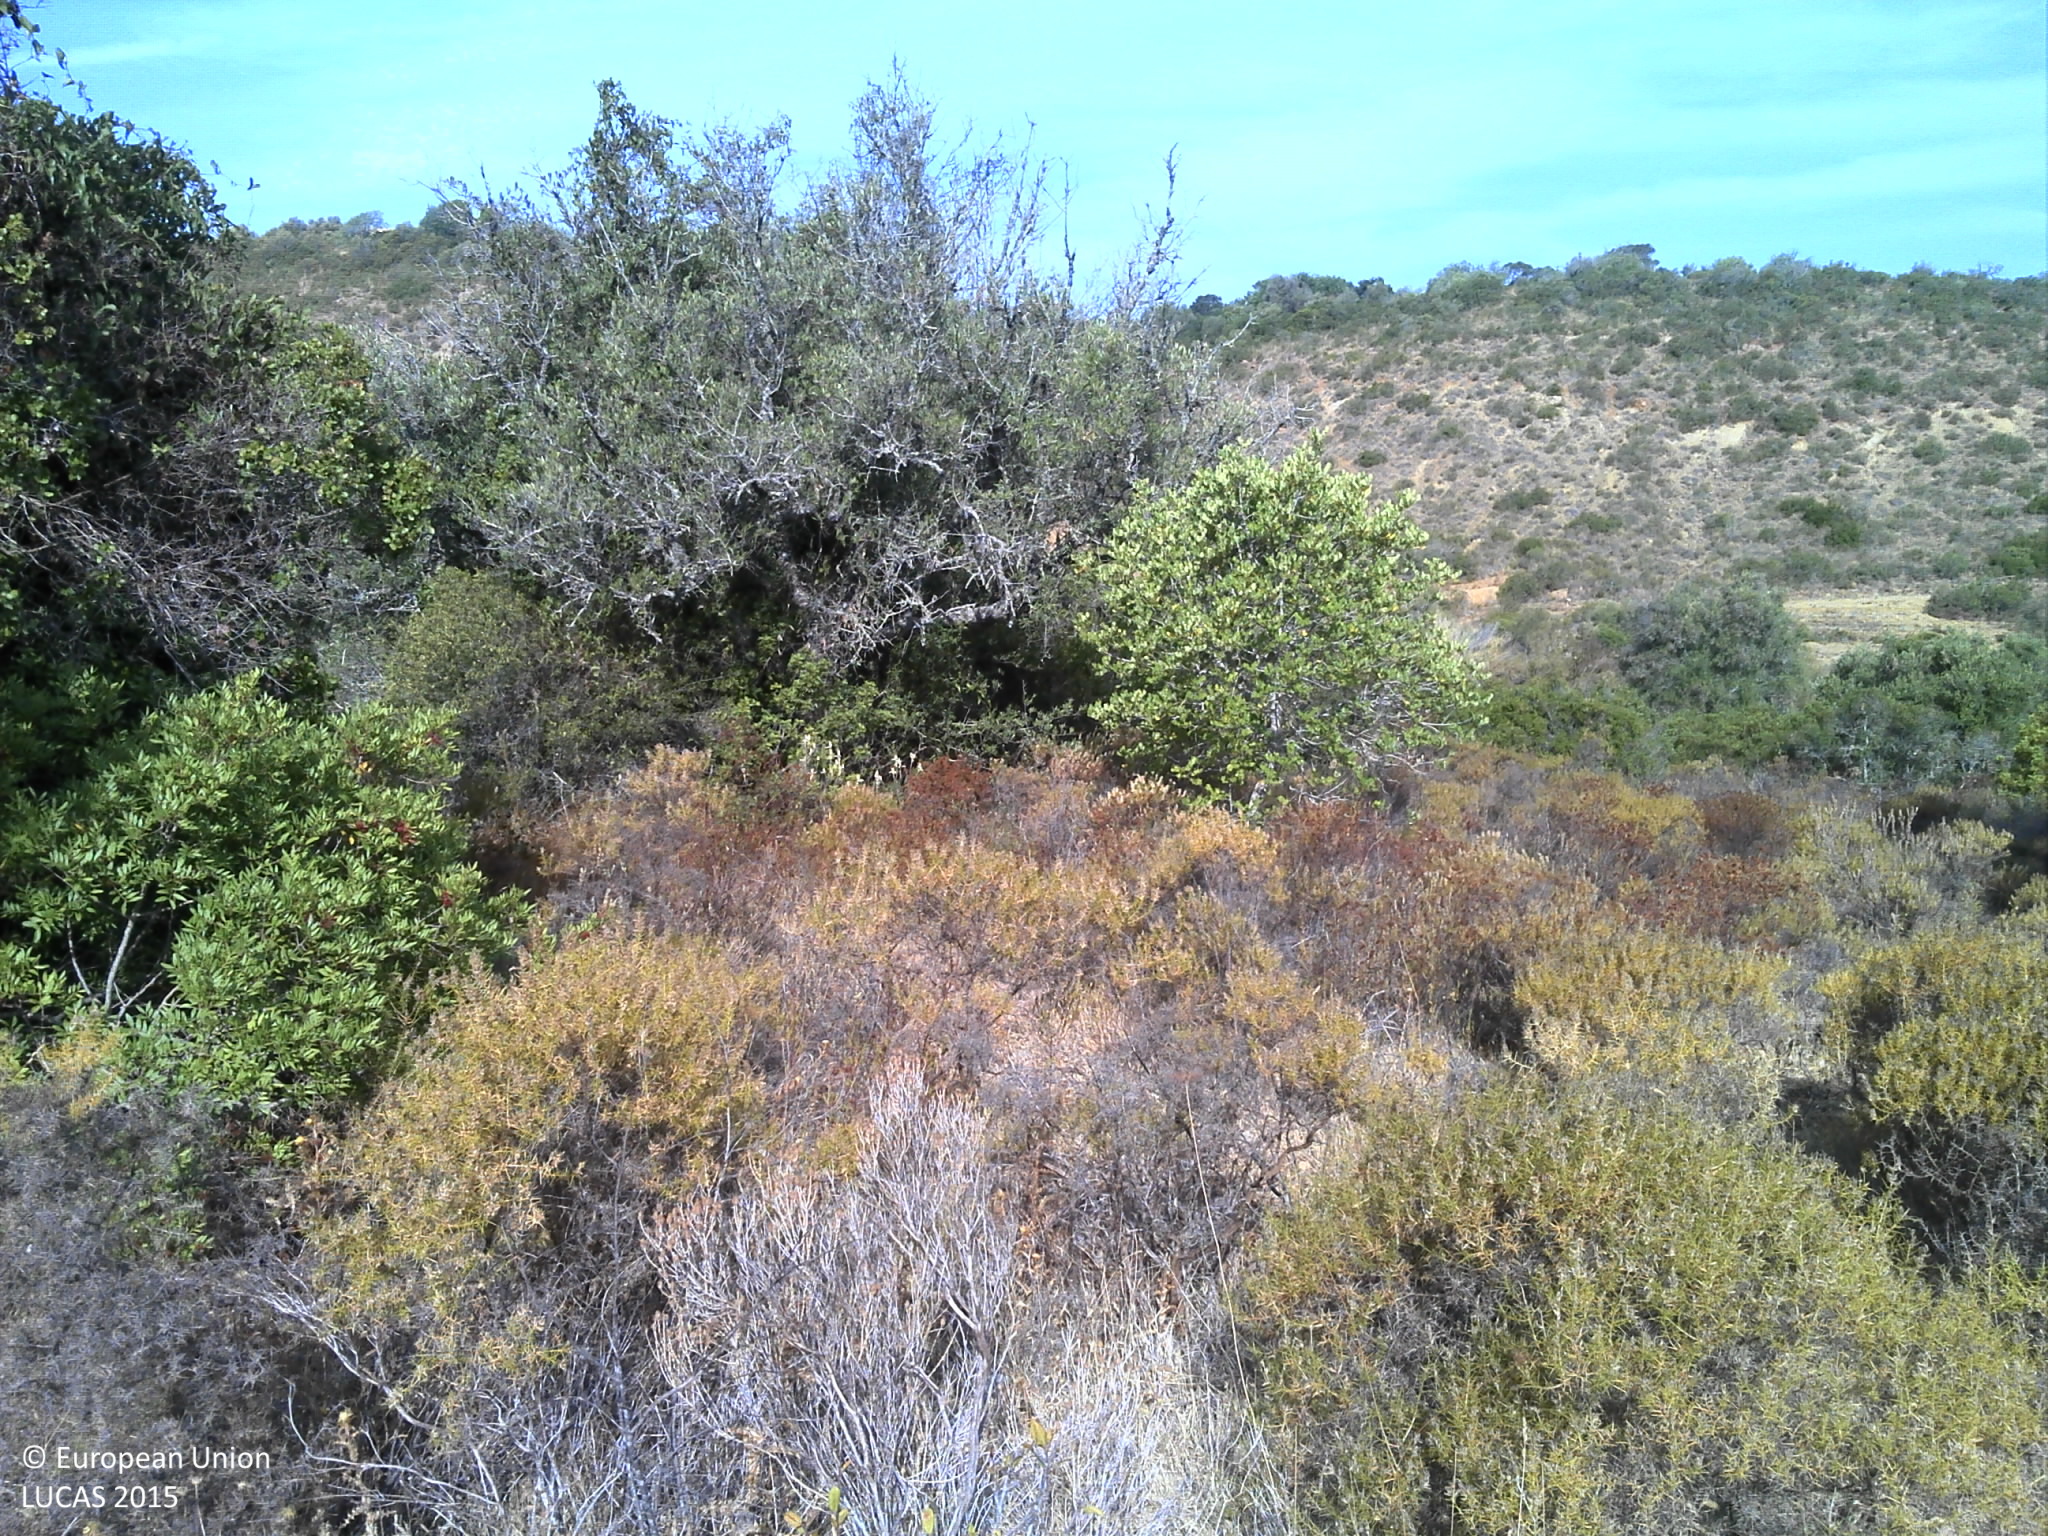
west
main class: Shrubland
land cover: Shrubland with sparse tree cover
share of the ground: 25 - 50 %
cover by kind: shrubs 40 %, unconsolidated bare surface 35 %, herbaceous plants 20 %, broadleaved forest trees 5 %
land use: Agriculture (excluding fallow land and kitchen gardens)
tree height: < 5 m
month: September
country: PT
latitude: 37.1432
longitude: -8.3839
